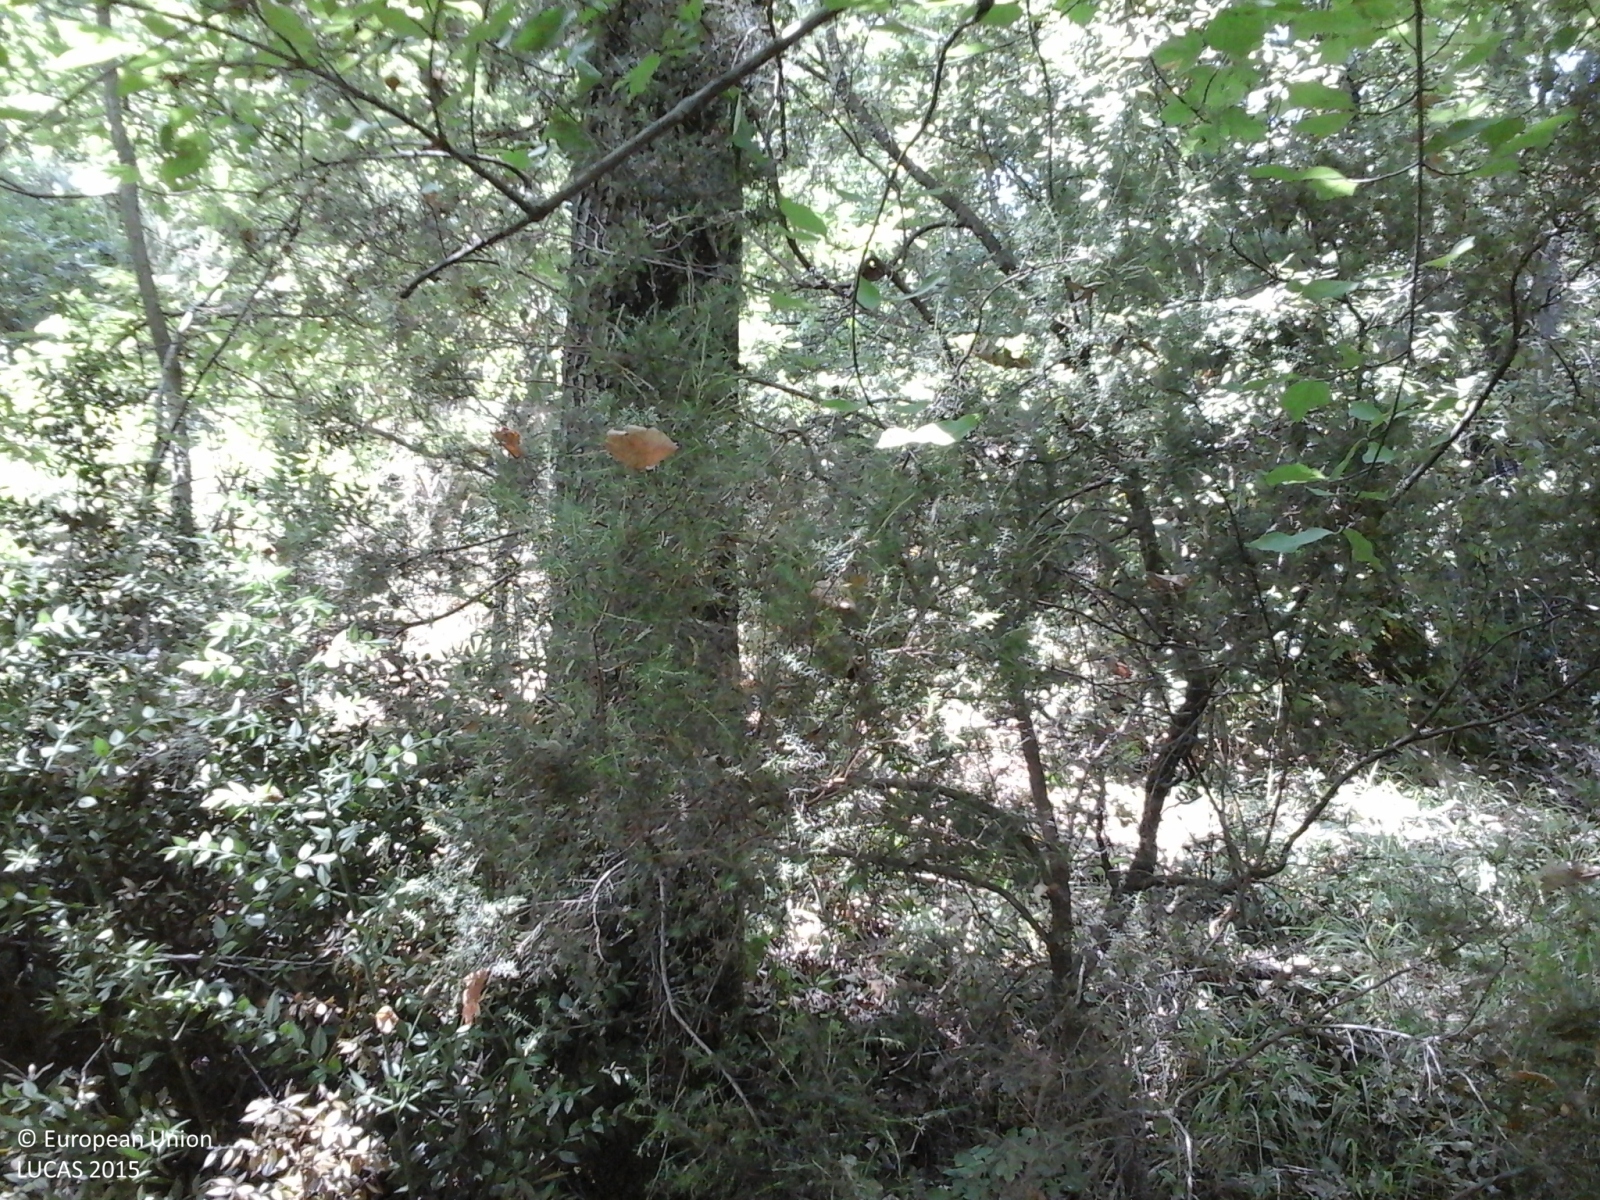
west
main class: Woodland
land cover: Broadleaved woodland
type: thermophilous deciduous forest
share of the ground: > 75 %
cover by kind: broadleaved forest trees 90 %, shrubs 10 %
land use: Forestry
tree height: > 5 m
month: July
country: IT
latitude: 43.0277
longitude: 11.0644
